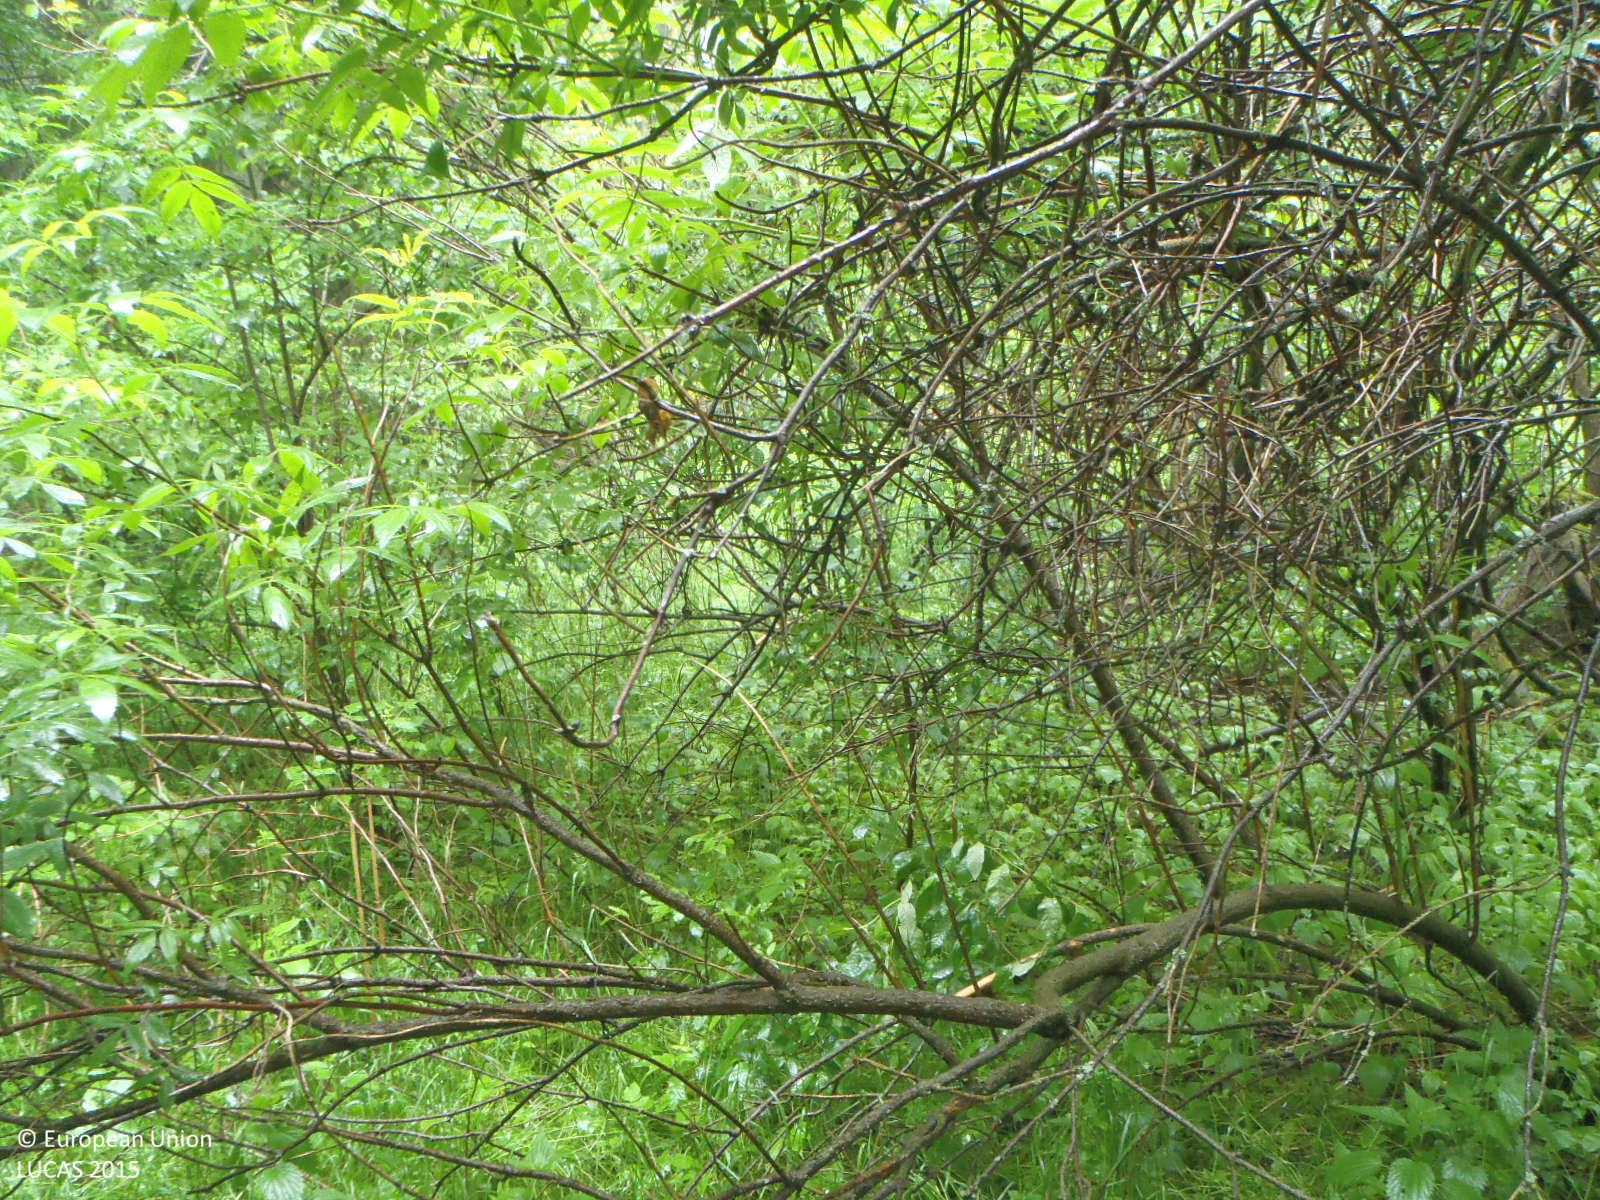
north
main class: Woodland
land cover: Broadleaved woodland
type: mesophytic deciduous forest
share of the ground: 50 - 75 %
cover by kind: broadleaved forest trees 70 %, herbaceous plants 20 %, shrubs 10 %
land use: Forestry
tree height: > 5 m
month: May
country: CZ
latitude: 48.7687
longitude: 14.3410
